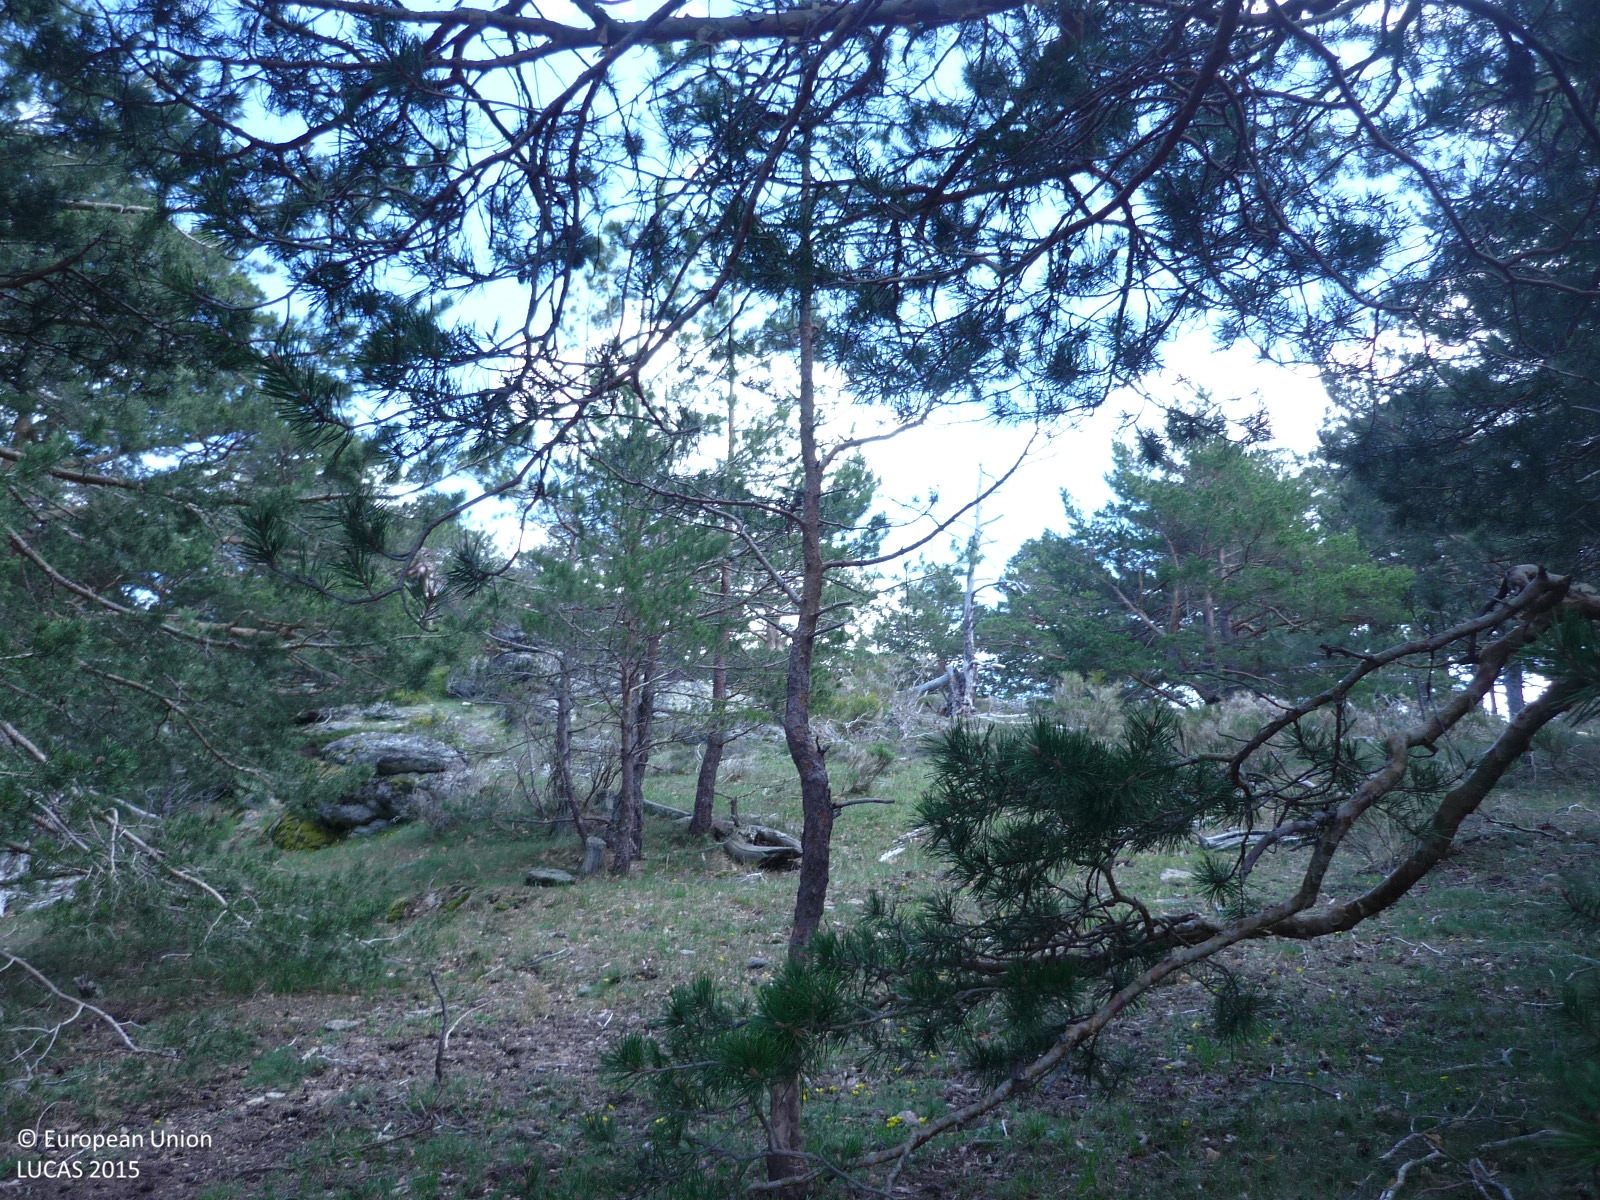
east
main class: Woodland
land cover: Pine dominated coniferous woodland
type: coniferous forest of the mediterranean region
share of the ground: > 75 %
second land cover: Grassland without tree/shrub cover
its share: > 75 %
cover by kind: coniferous forest trees 80 %, shrubs 10 %, herbaceous plants 10 %
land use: Forestry
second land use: Agriculture (excluding fallow land and kitchen gardens)
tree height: > 5 m
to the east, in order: Pine dominated coniferous woodland; Grassland without tree/shrub cover
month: May
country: ES
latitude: 40.8466
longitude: -3.9115
